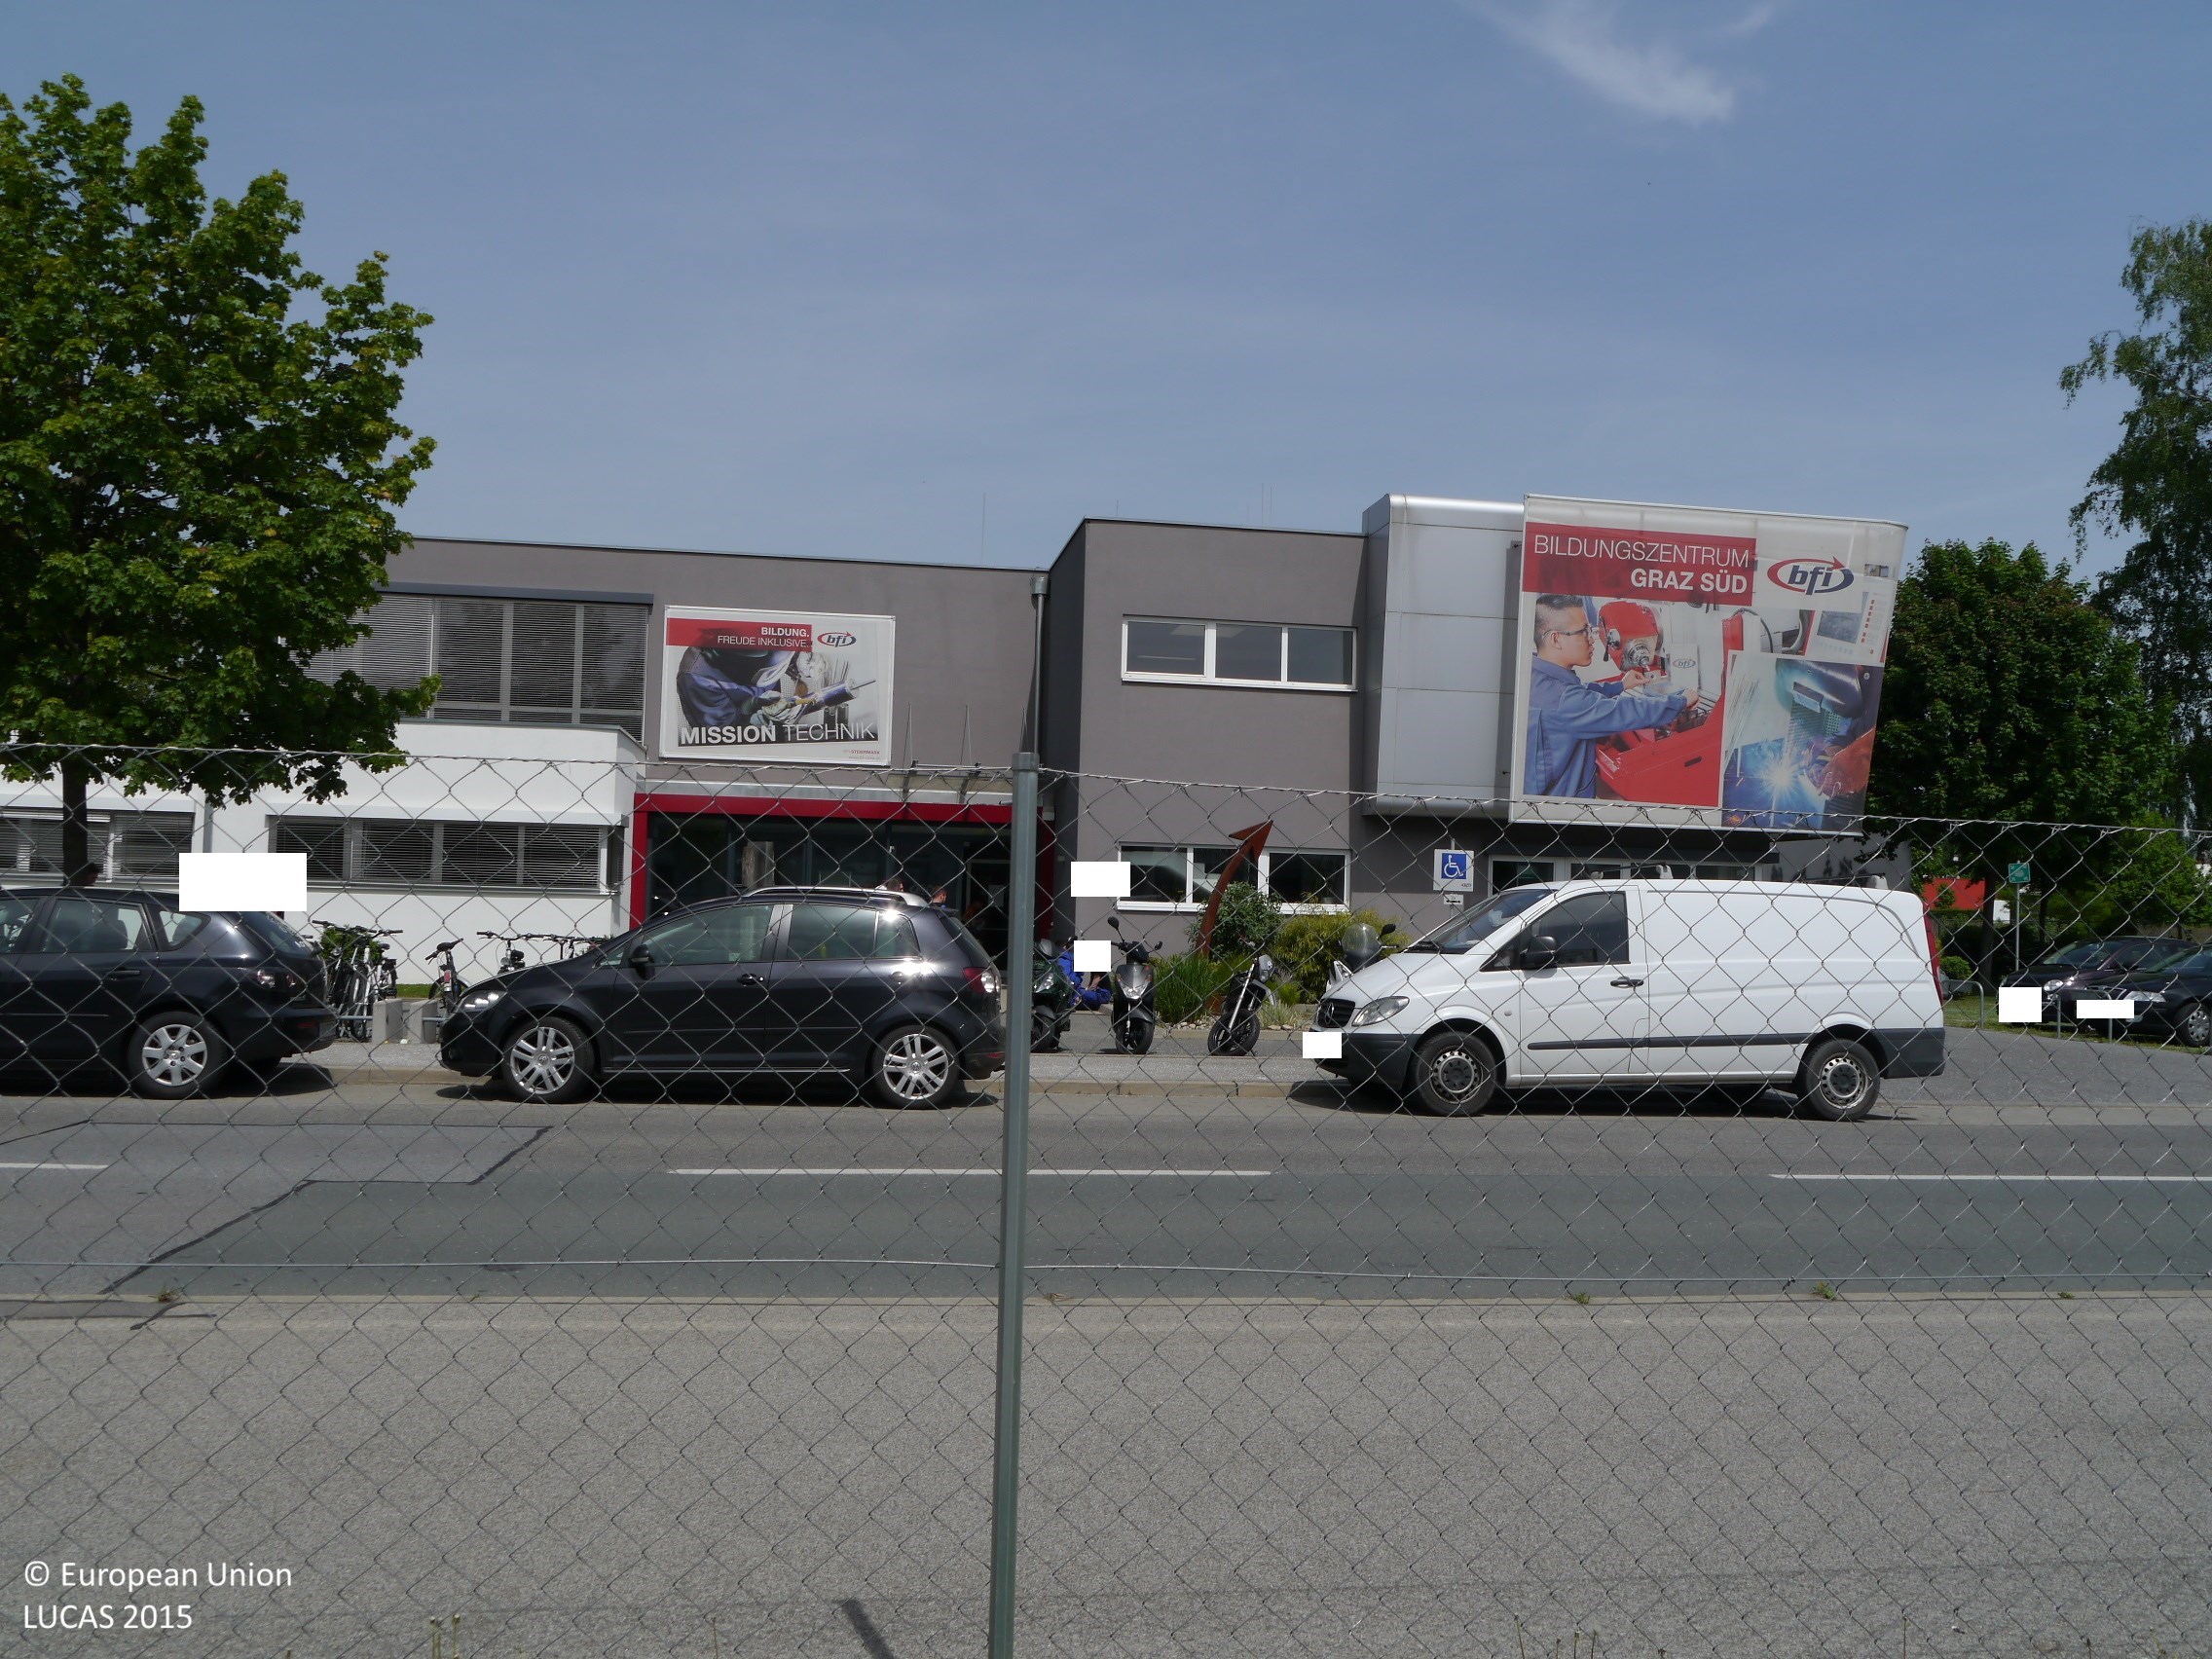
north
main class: Grassland
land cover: Grassland with sparse tree/shrub cover
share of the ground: > 75 %
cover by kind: herbaceous plants 95 %, broadleaved forest trees 5 %
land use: Commerce
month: May
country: AT
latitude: 47.0432
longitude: 15.4356
